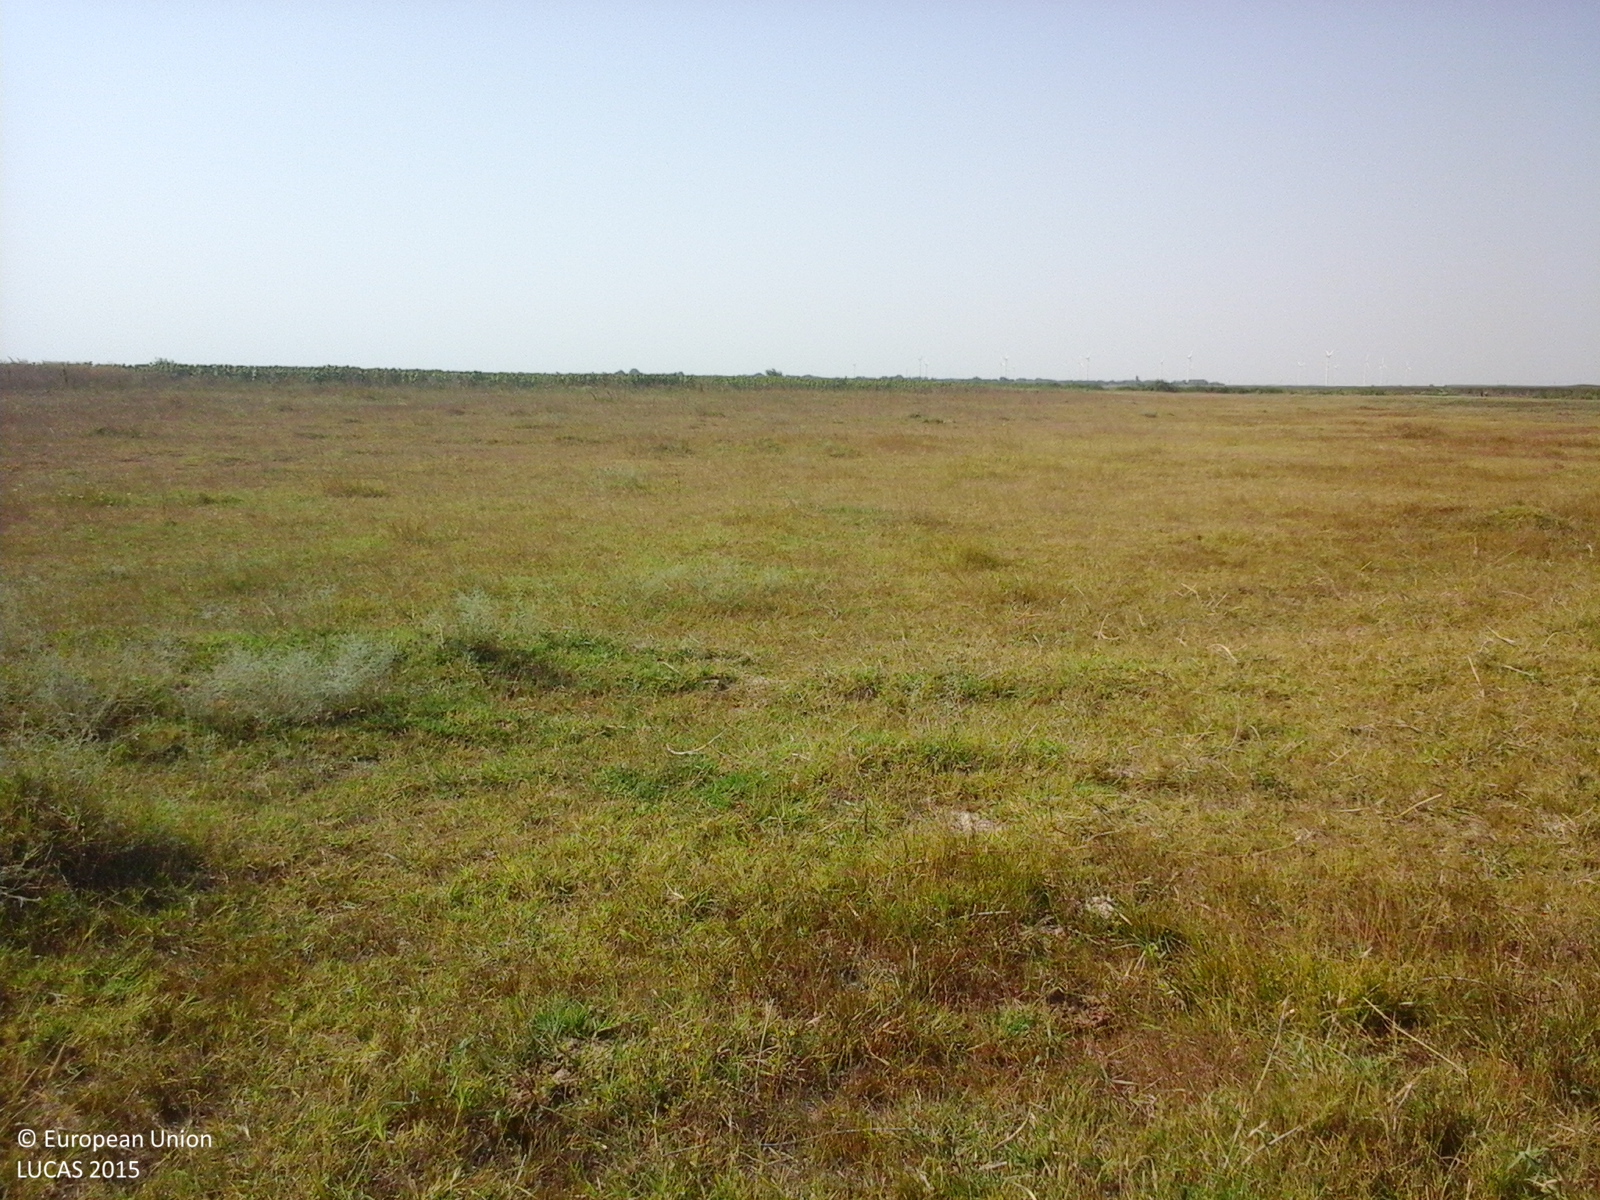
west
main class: Grassland
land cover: Grassland without tree/shrub cover
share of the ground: > 75 %
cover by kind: herbaceous plants 100 %
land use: Agriculture (excluding fallow land and kitchen gardens)
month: August
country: RO
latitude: 45.2074
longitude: 27.7142
